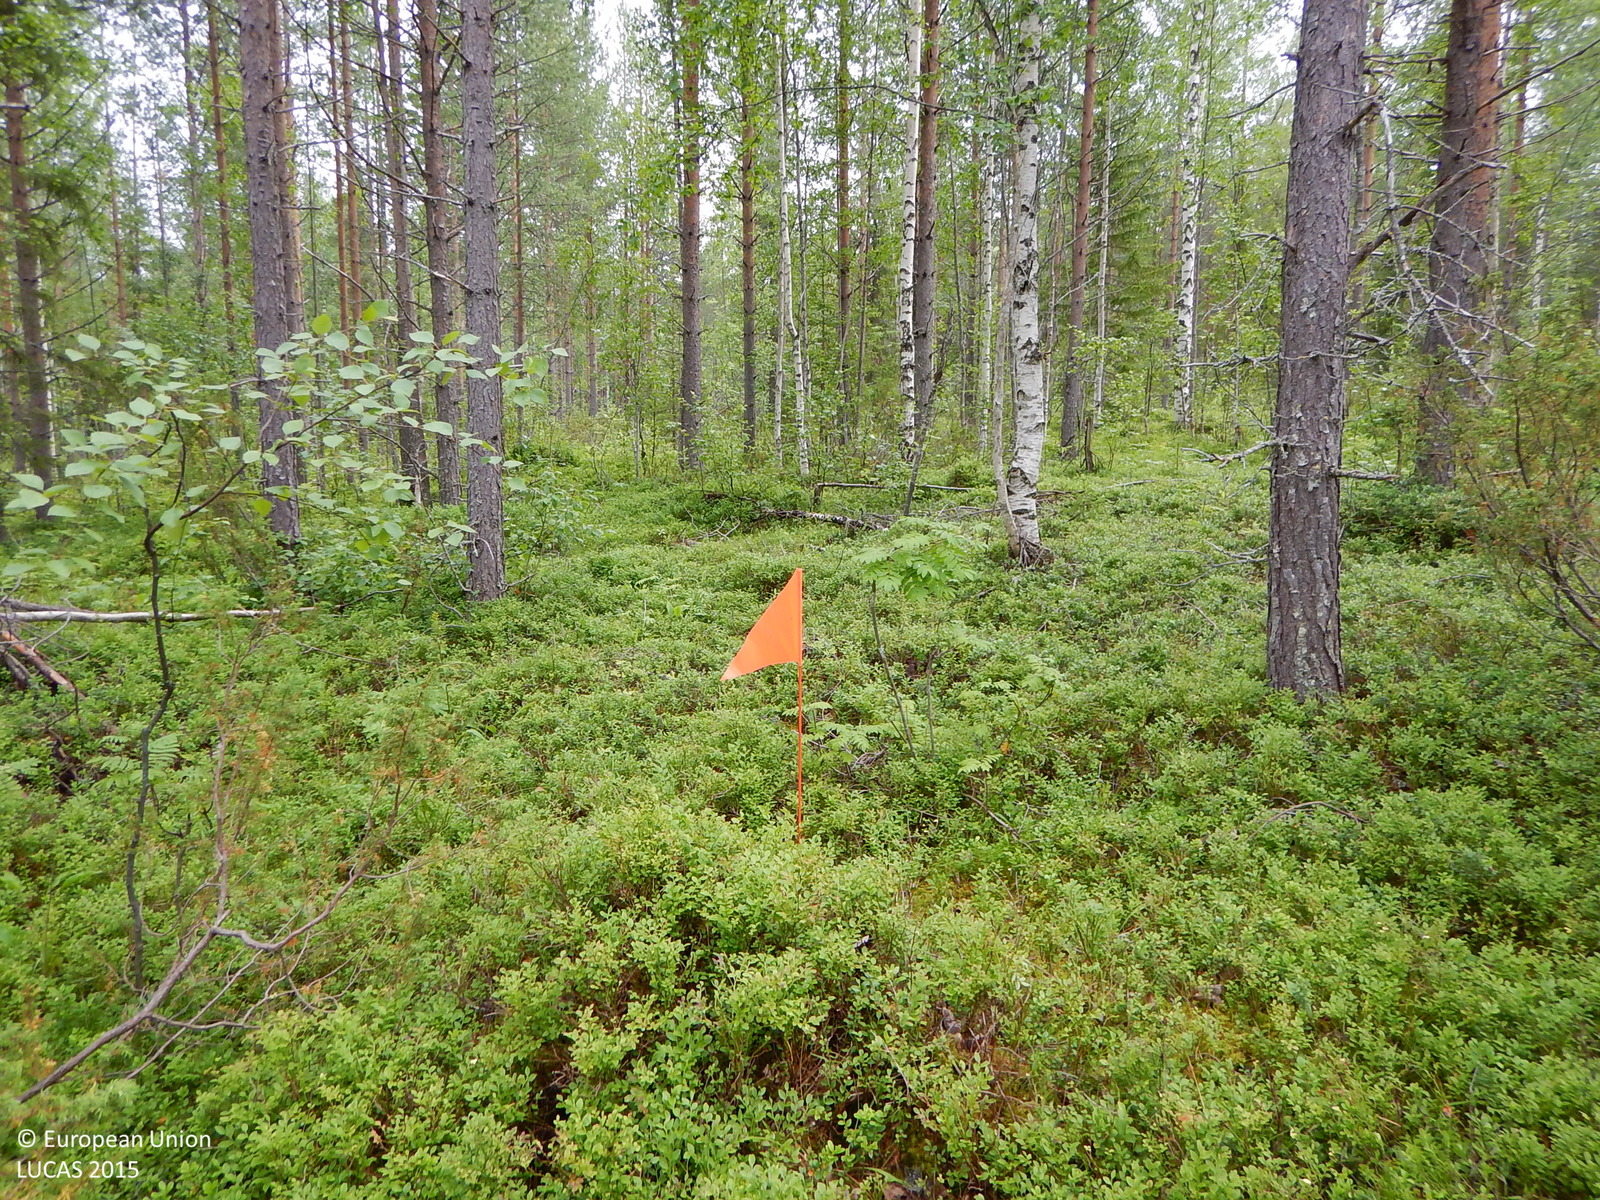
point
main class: Woodland
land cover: Pine dominated mixed woodland
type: boreal forest
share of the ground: 25 - 50 %
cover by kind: shrubs 35 %, coniferous forest trees 30 %, herbaceous plants 15 %, broadleaved forest trees 10 %, lichens and mosses 10 %
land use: Forestry
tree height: > 5 m
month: July
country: SE
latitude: 64.9113
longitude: 20.4353
